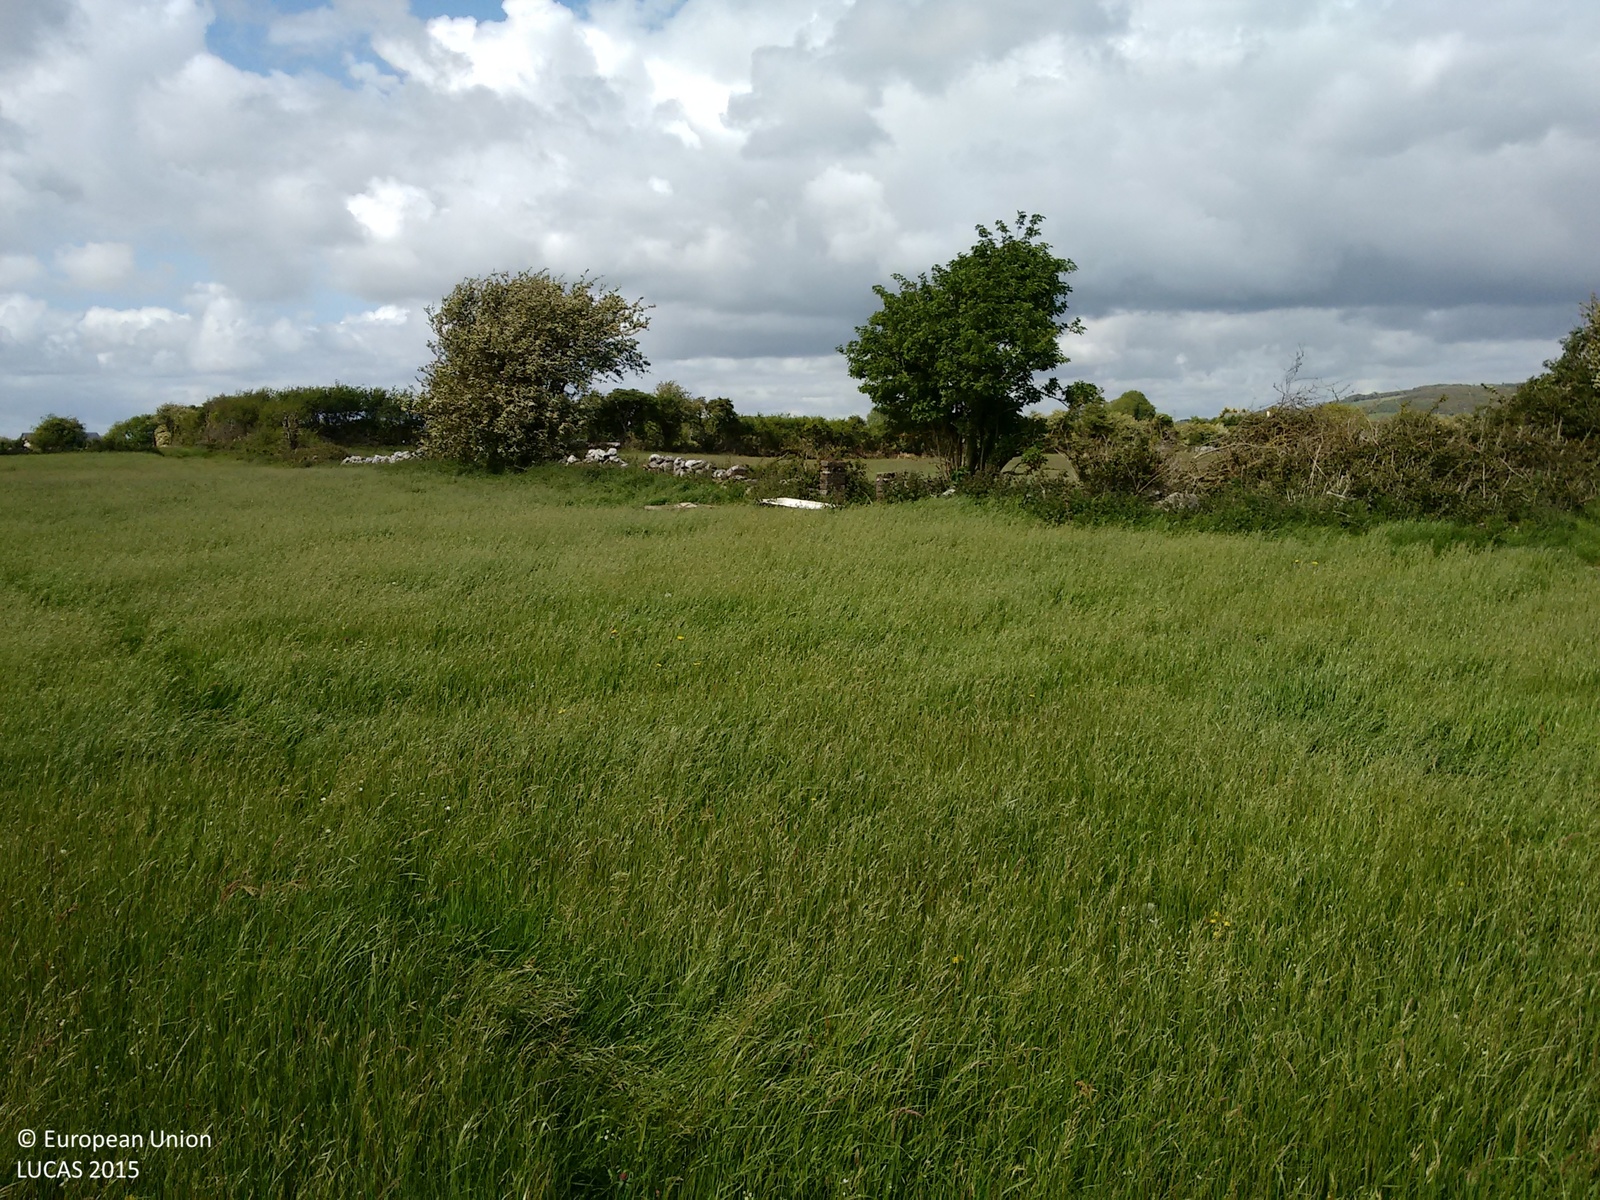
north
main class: Grassland
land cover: Grassland without tree/shrub cover
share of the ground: > 75 %
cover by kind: herbaceous plants 100 %
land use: Agriculture (excluding fallow land and kitchen gardens)
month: June
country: IE
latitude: 53.4515
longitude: -8.9897
